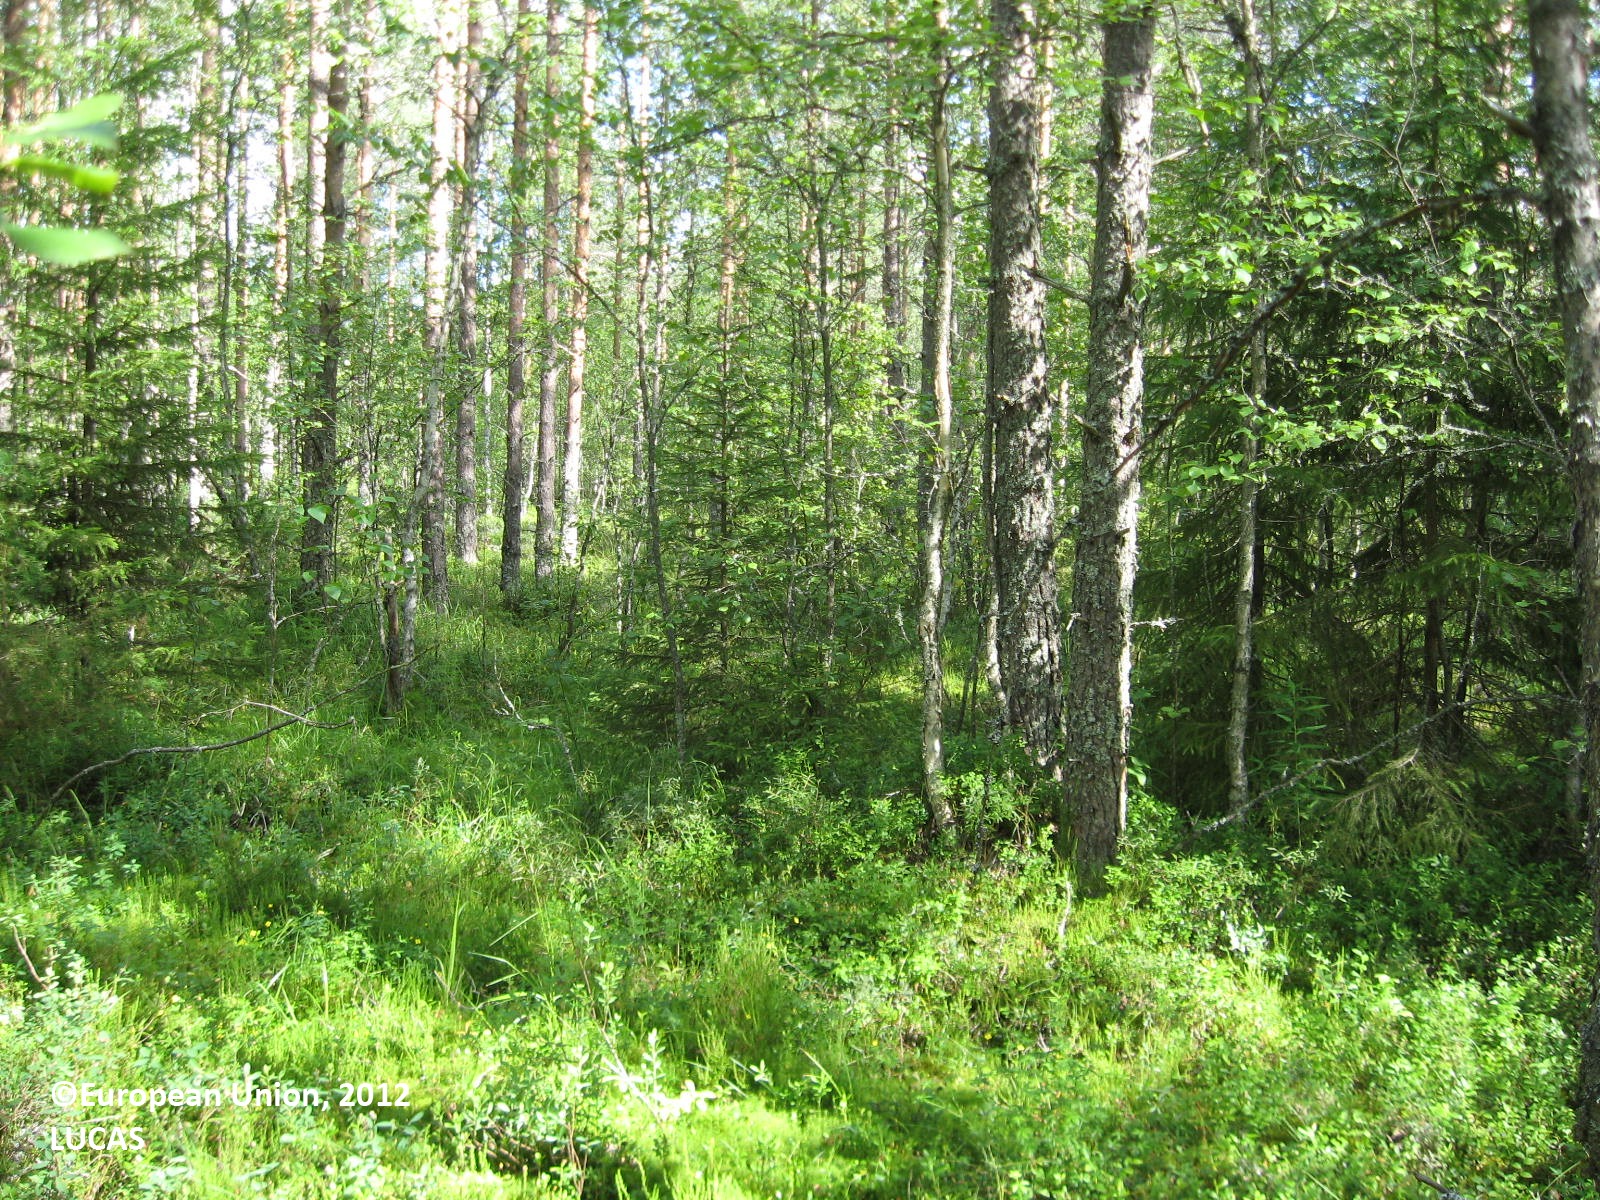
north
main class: Woodland
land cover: Pine dominated mixed woodland
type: boreal forest
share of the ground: > 75 %
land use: Forestry
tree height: > 5 m
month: July
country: FI
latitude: 62.1028
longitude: 22.3371
